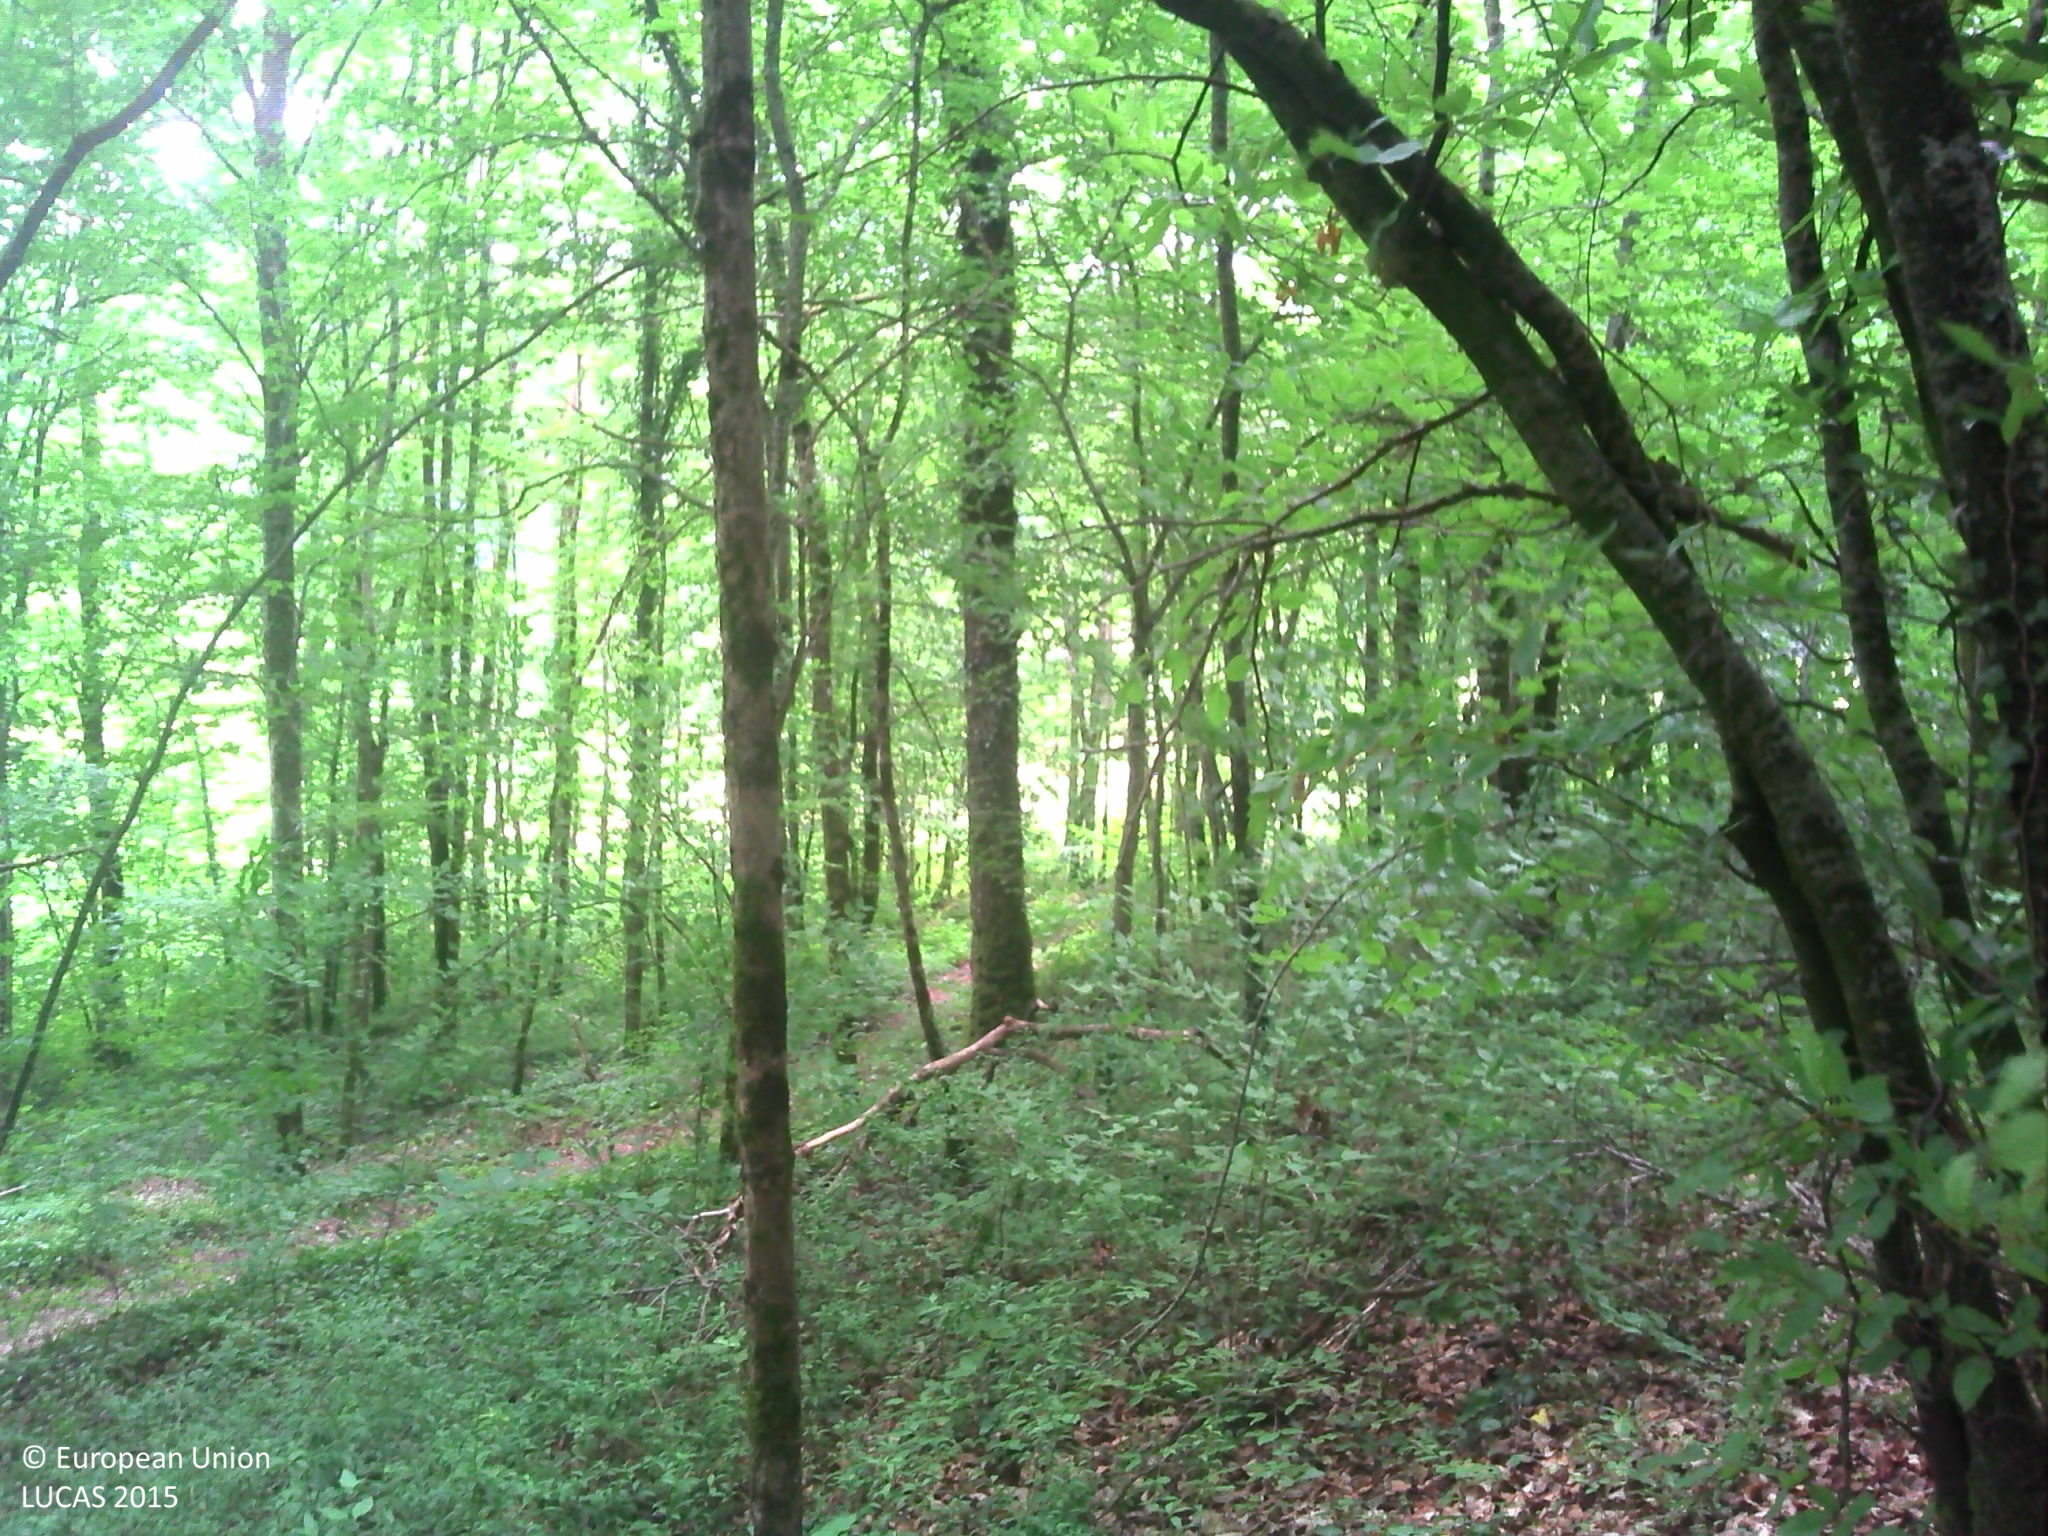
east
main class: Woodland
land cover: Broadleaved woodland
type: acidophilous oak and oak-birch forest
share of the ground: > 75 %
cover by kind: broadleaved forest trees 90 %, herbaceous plants 10 %
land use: Forestry
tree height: > 5 m
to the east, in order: Broadleaved woodland; Tracks; Broadleaved woodland; Grassland without tree/shrub cover; Grass margins; Paved roads, cycling and walking lanes; Grass margins; Fences; Maize; Grass margins; Abandoned hedges; Rivers and streams; Grass margins; Maize; Fences; Broadleaved woodland
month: June
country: FR
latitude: 48.2341
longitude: 4.9499
